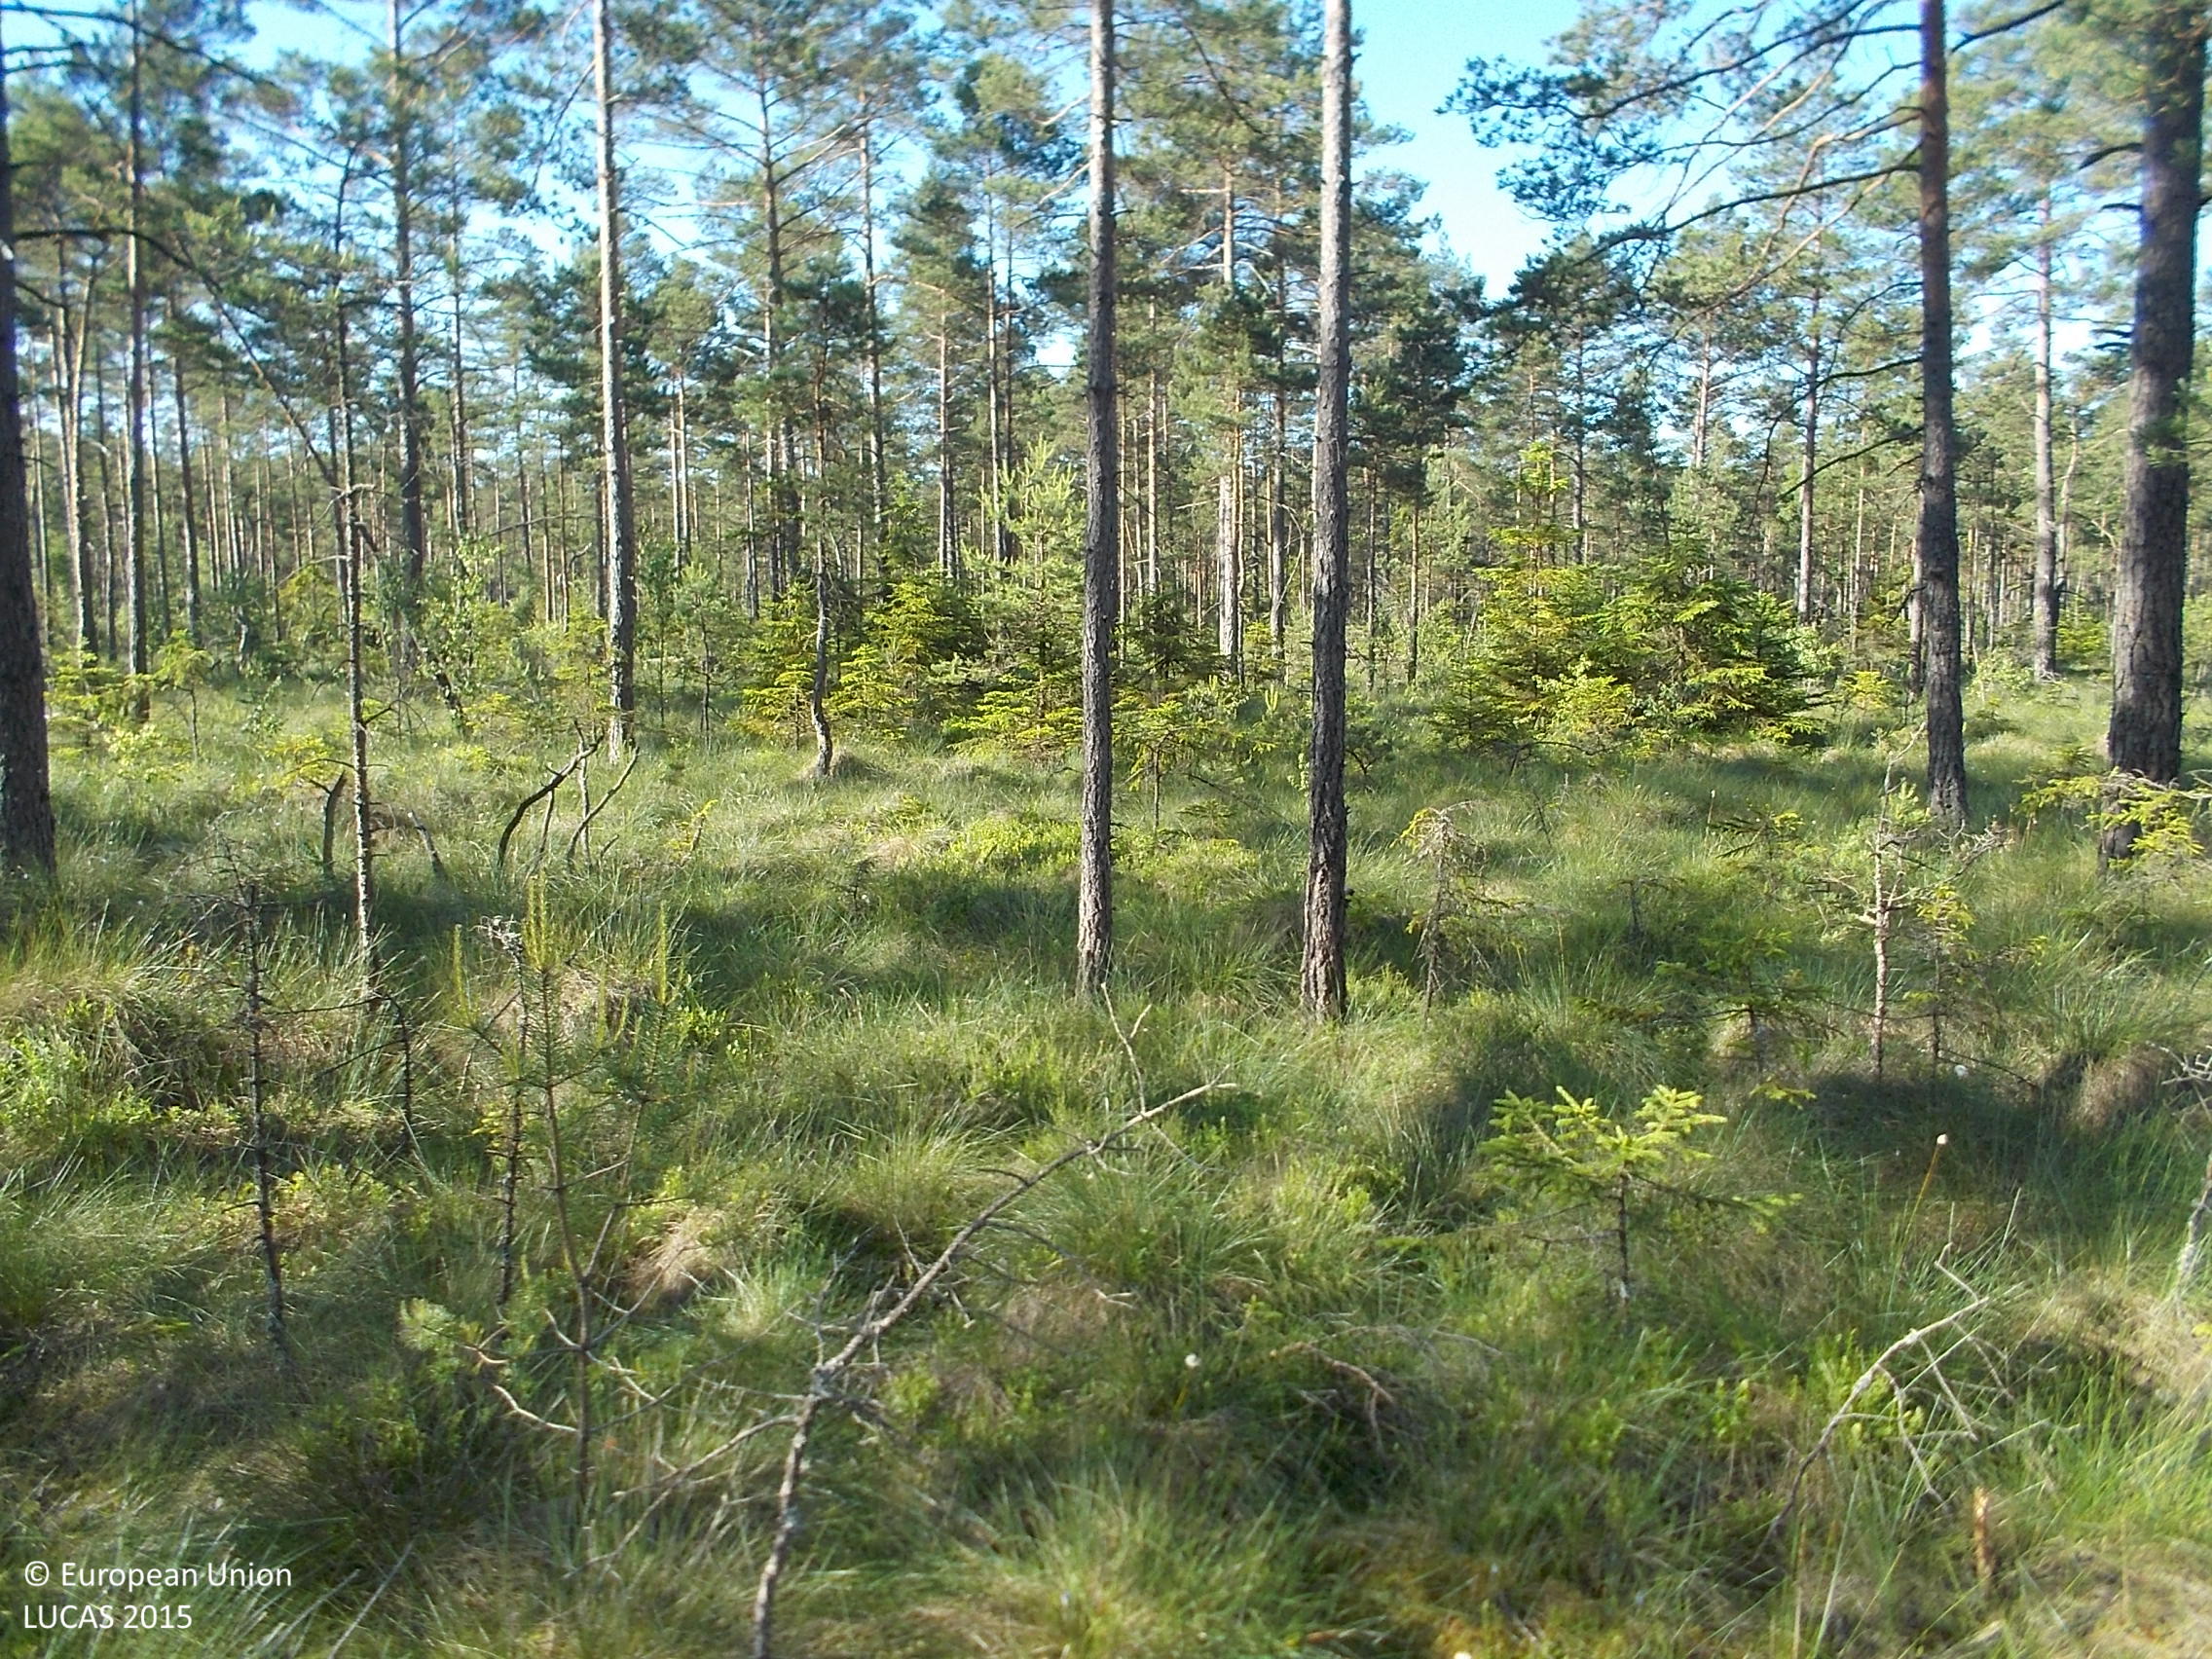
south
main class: Woodland
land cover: Pine dominated coniferous woodland
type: boreal forest
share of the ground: 50 - 75 %
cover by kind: coniferous forest trees 60 %, herbaceous plants 35 %, lichens and mosses 5 %
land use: Forestry
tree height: > 5 m
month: July
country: SE
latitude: 57.2465
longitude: 13.1614
